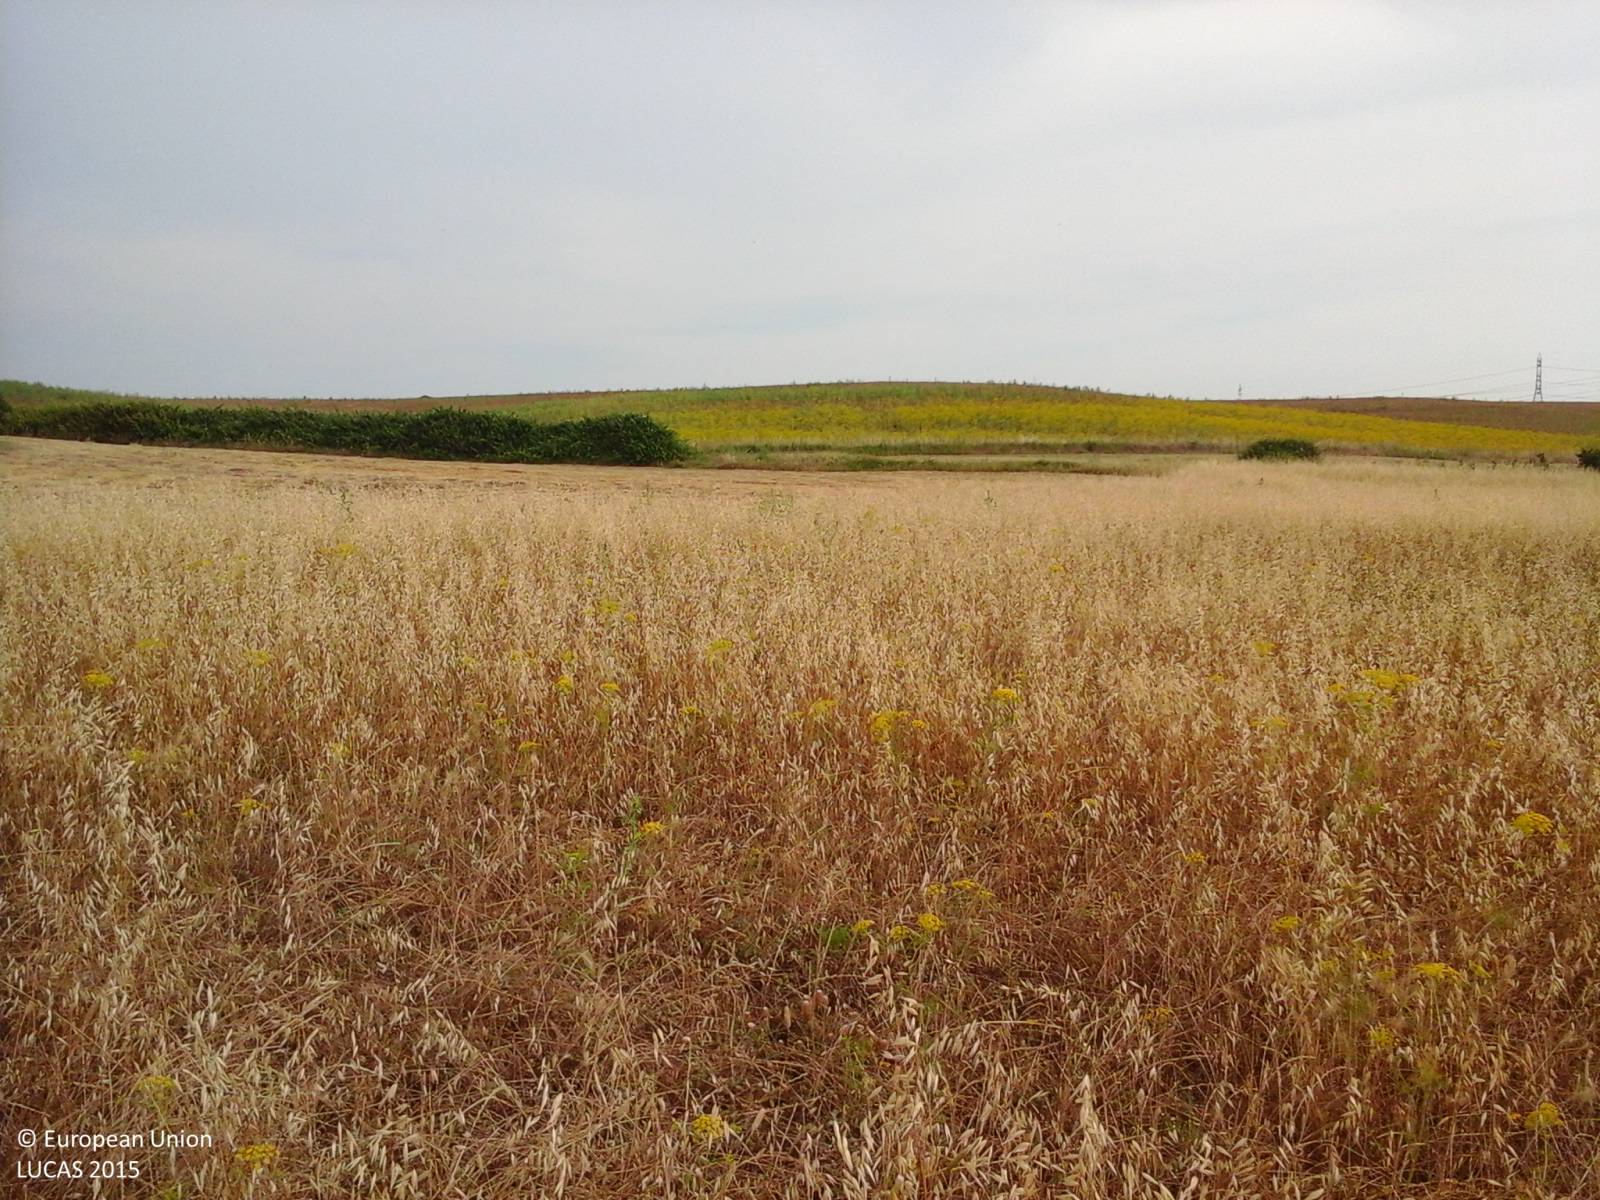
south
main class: Cropland
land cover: Oats
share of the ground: > 75 %
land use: Agriculture (excluding fallow land and kitchen gardens)
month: June
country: IT
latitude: 42.3887
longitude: 11.5857
